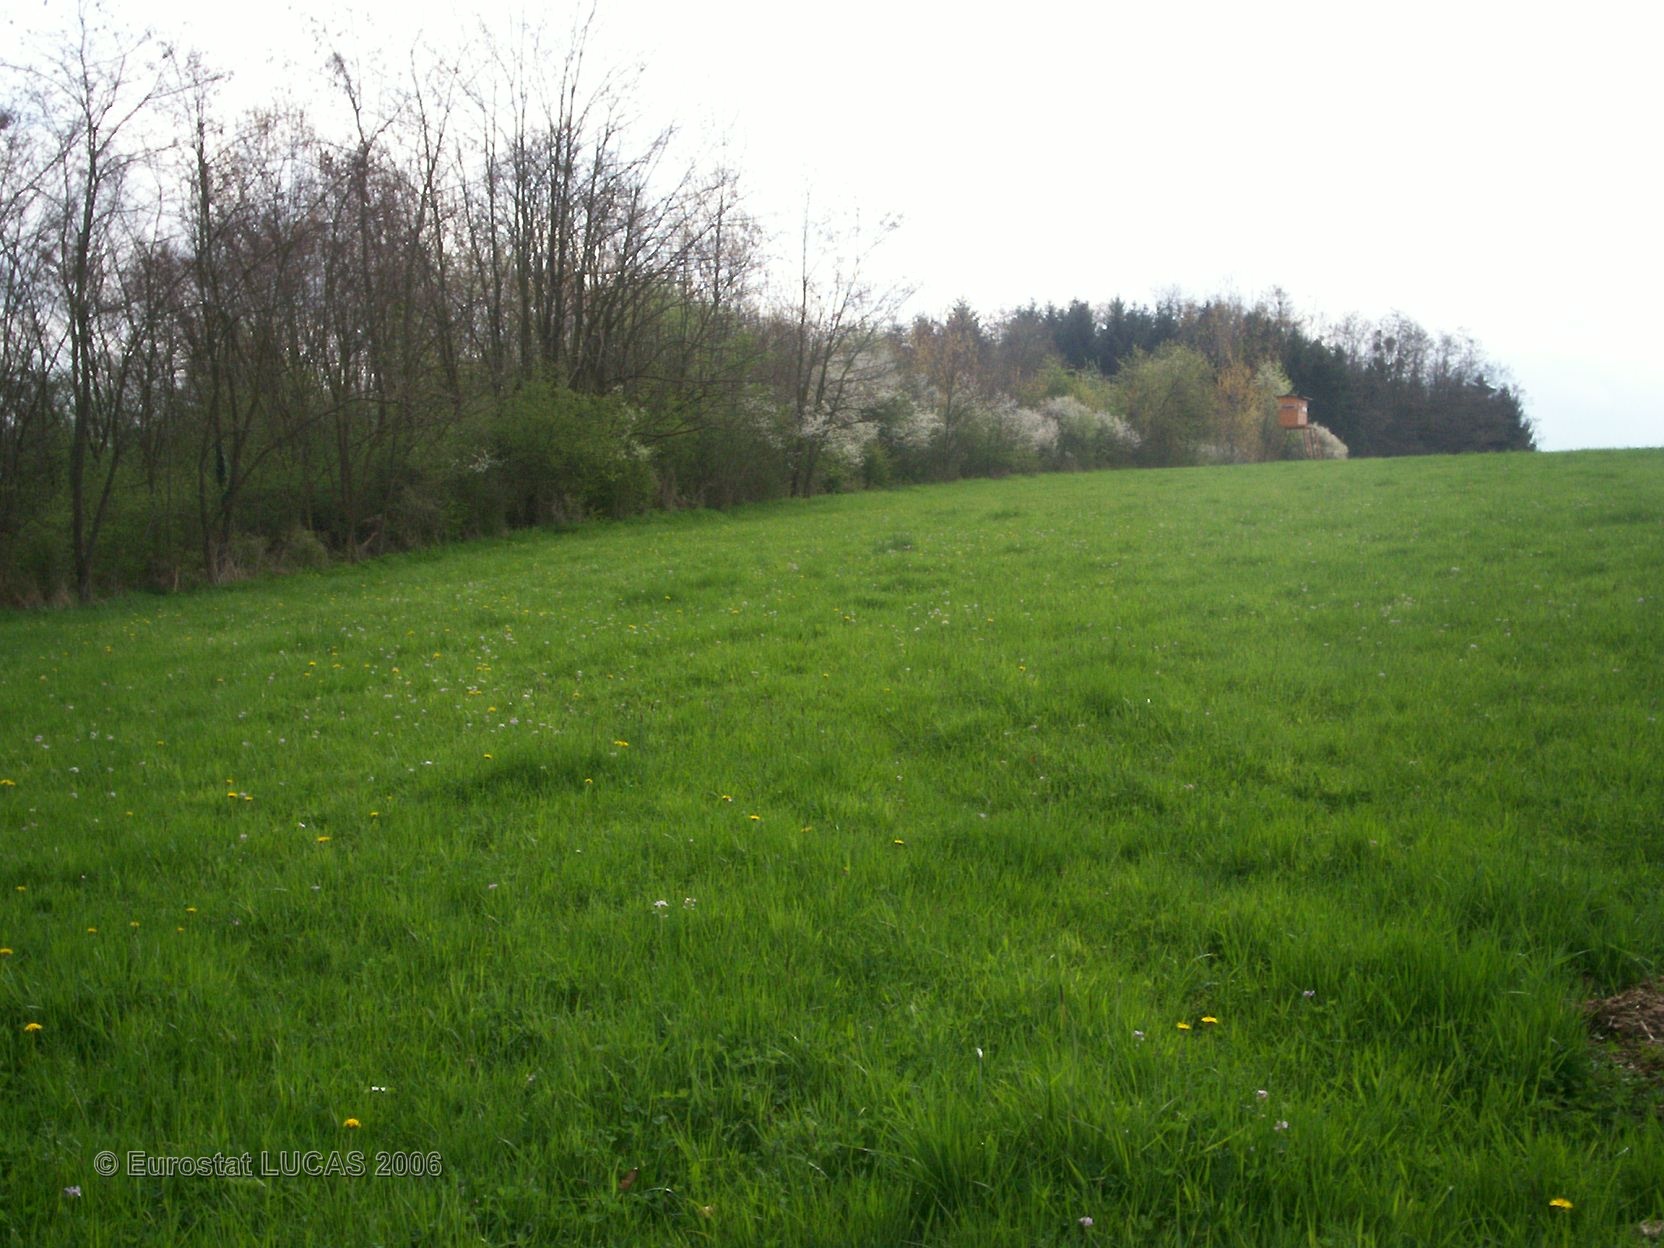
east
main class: Grassland
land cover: Grassland without tree/shrub cover
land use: Agriculture (excluding fallow land and kitchen gardens)
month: April
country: FR
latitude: 48.7878
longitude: 6.7474
